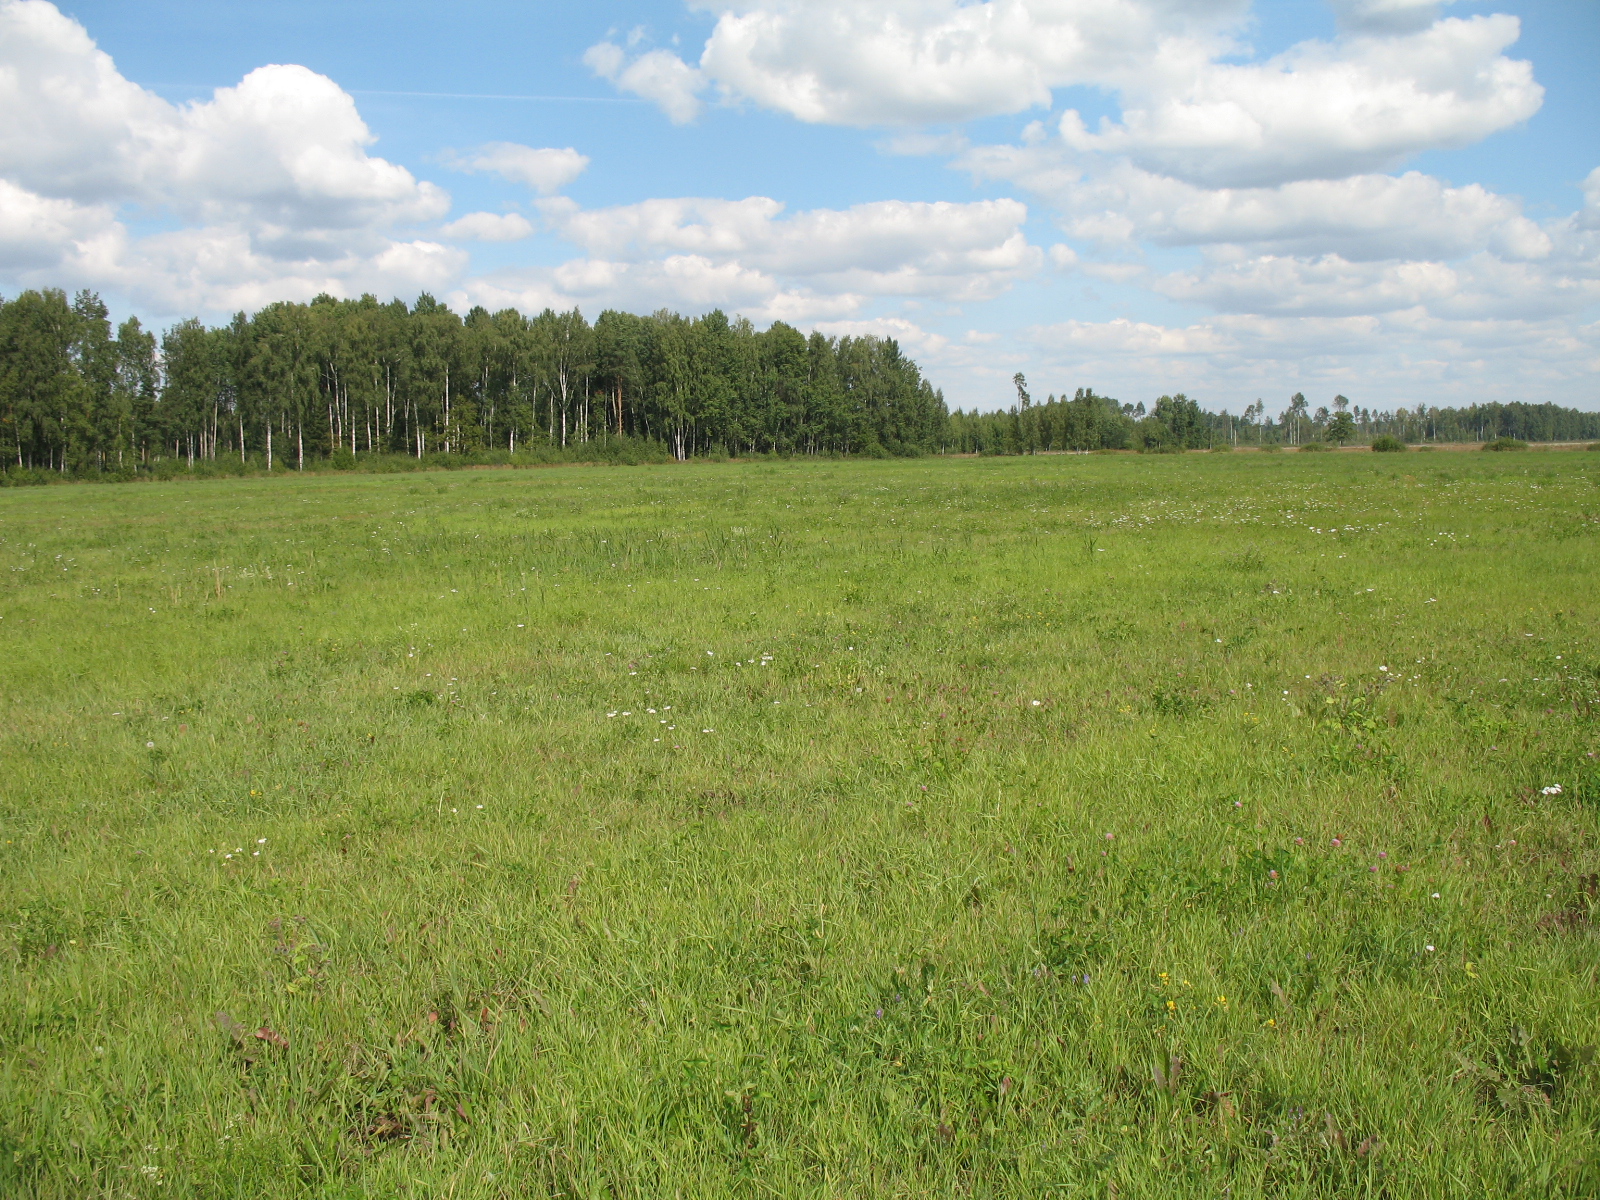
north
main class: Grassland
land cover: Grassland without tree/shrub cover
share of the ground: > 75 %
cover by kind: herbaceous plants 95 %, unconsolidated bare surface 5 %
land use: Agriculture (excluding fallow land and kitchen gardens)
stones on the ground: < 10 %
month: August
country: LV
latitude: 56.3372
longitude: 26.1029
